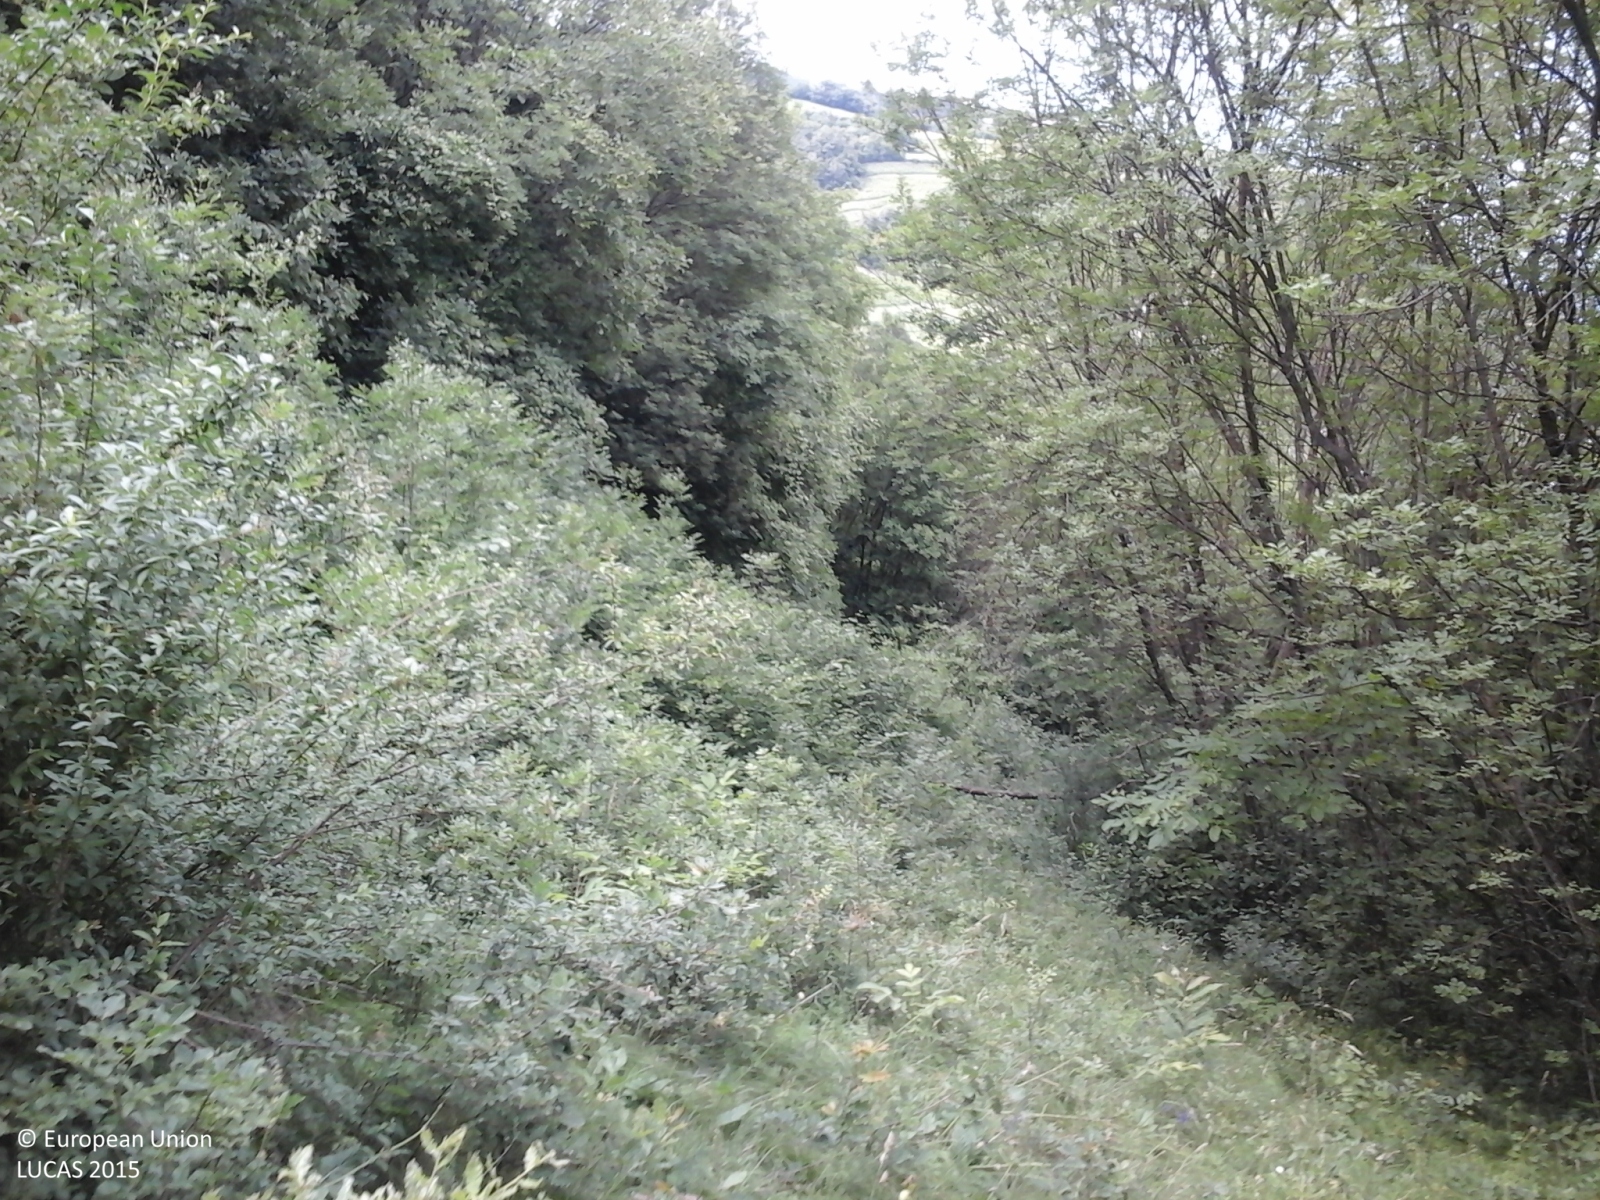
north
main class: Woodland
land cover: Broadleaved woodland
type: mesophytic deciduous forest
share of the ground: > 75 %
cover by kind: broadleaved forest trees 100 %
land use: Forestry
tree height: > 5 m
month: June
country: IT
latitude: 46.6634
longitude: 11.6057
